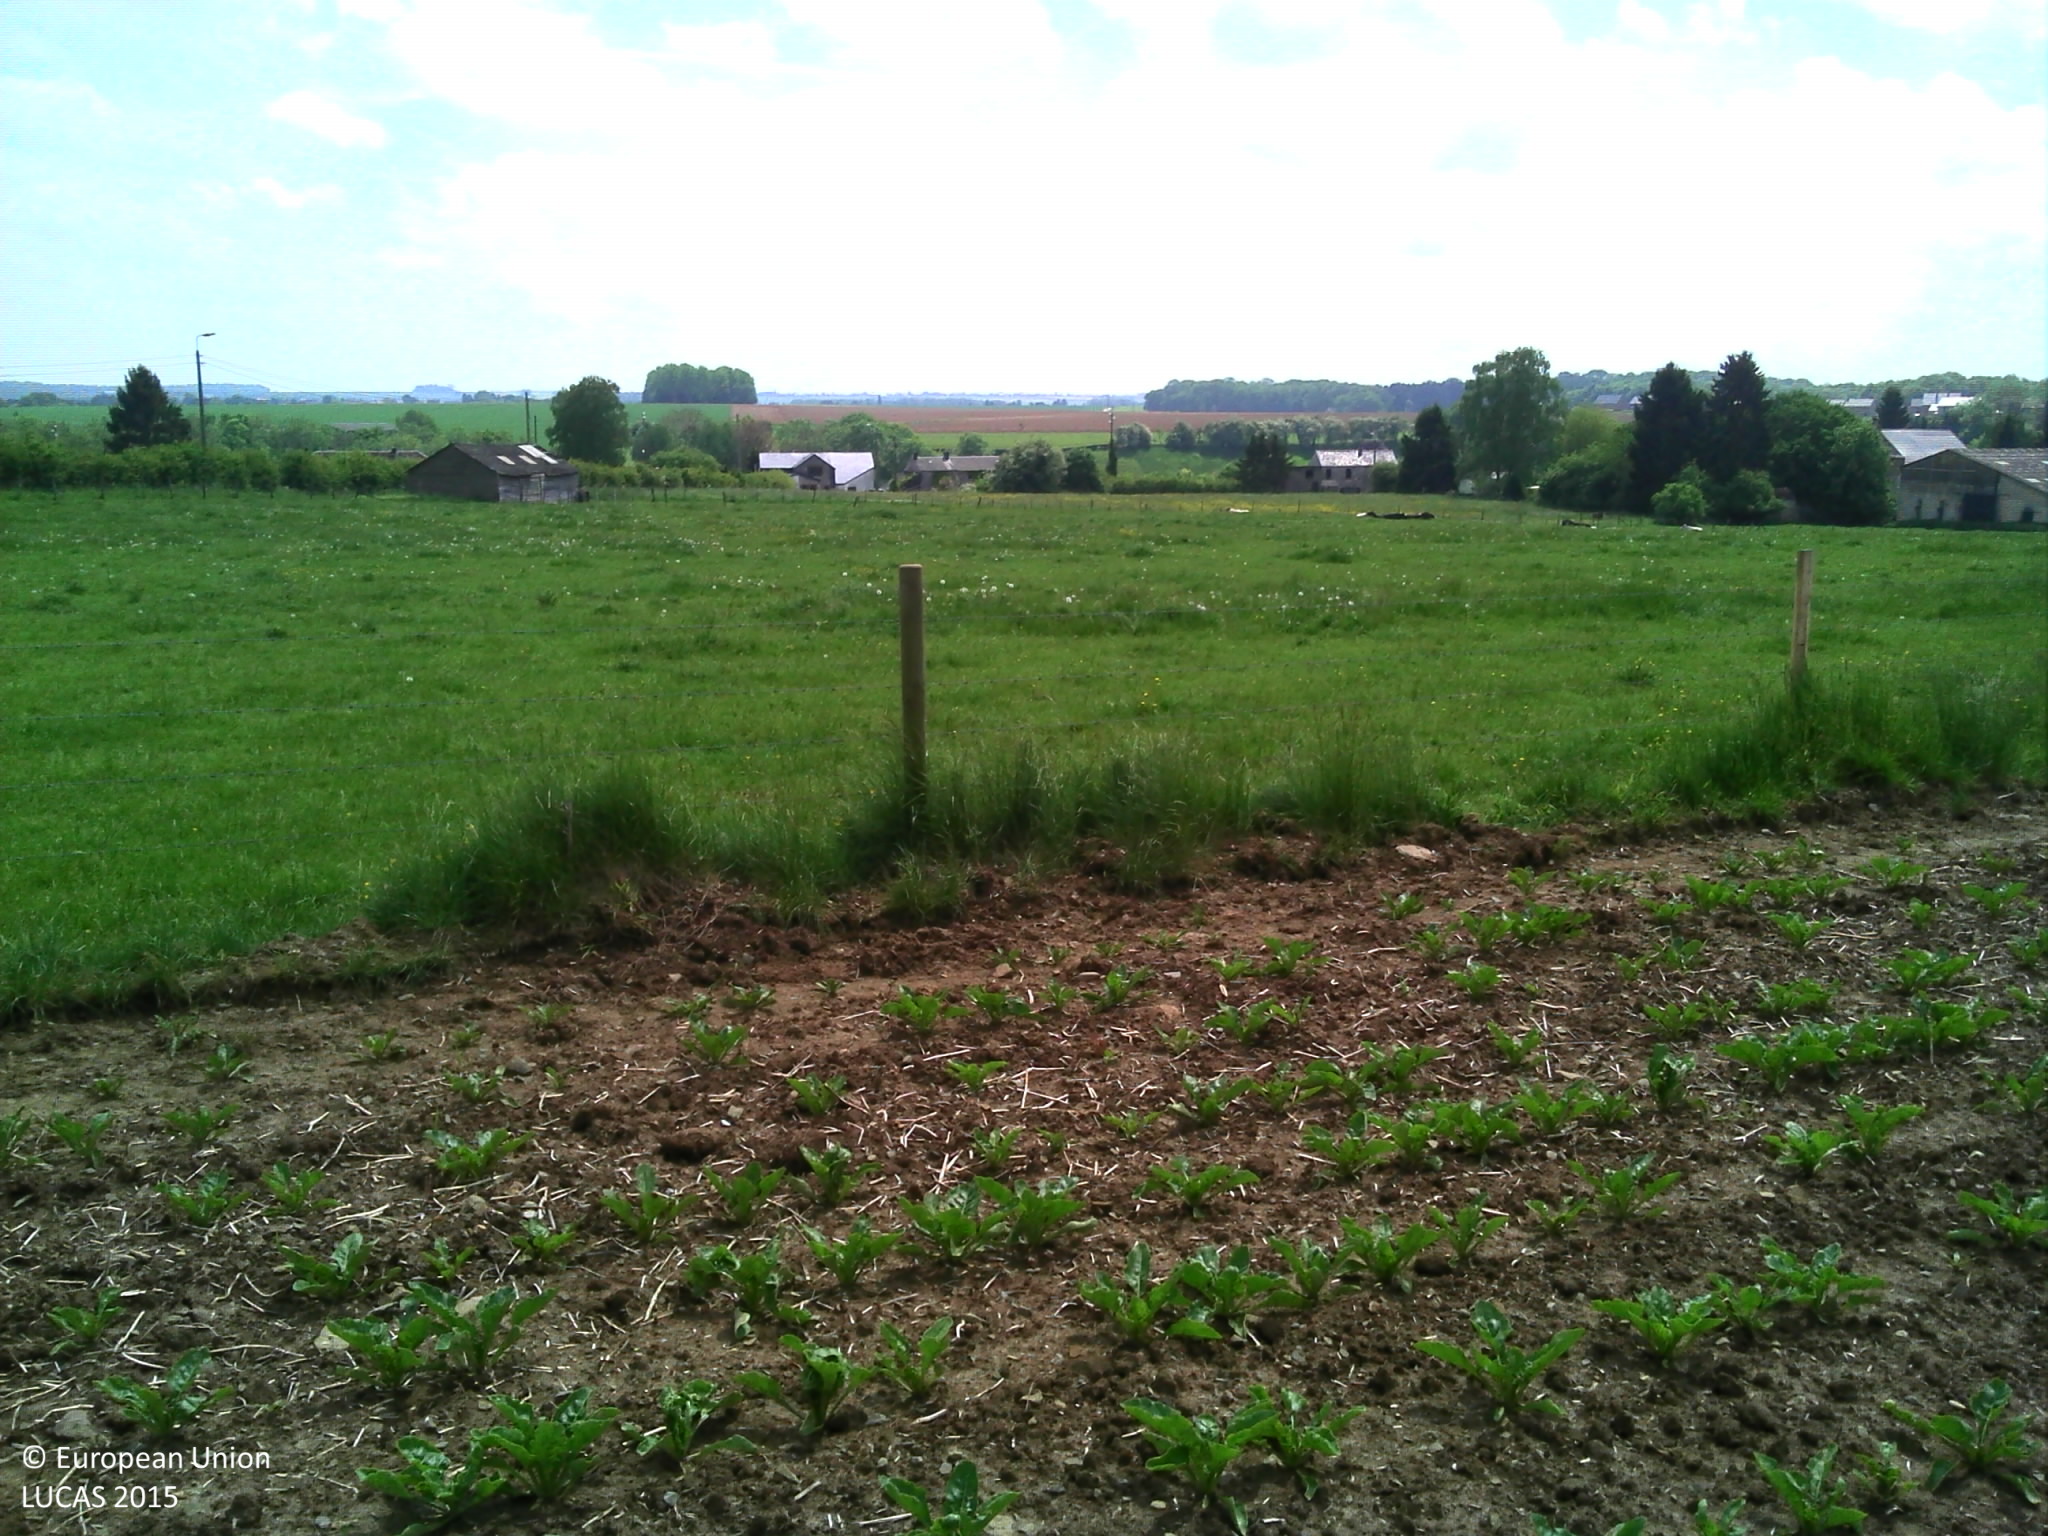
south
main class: Cropland
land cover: Sugar beet
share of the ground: > 75 %
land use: Agriculture (excluding fallow land and kitchen gardens)
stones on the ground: < 10 %
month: May
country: BE
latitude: 50.4480
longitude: 5.3083
